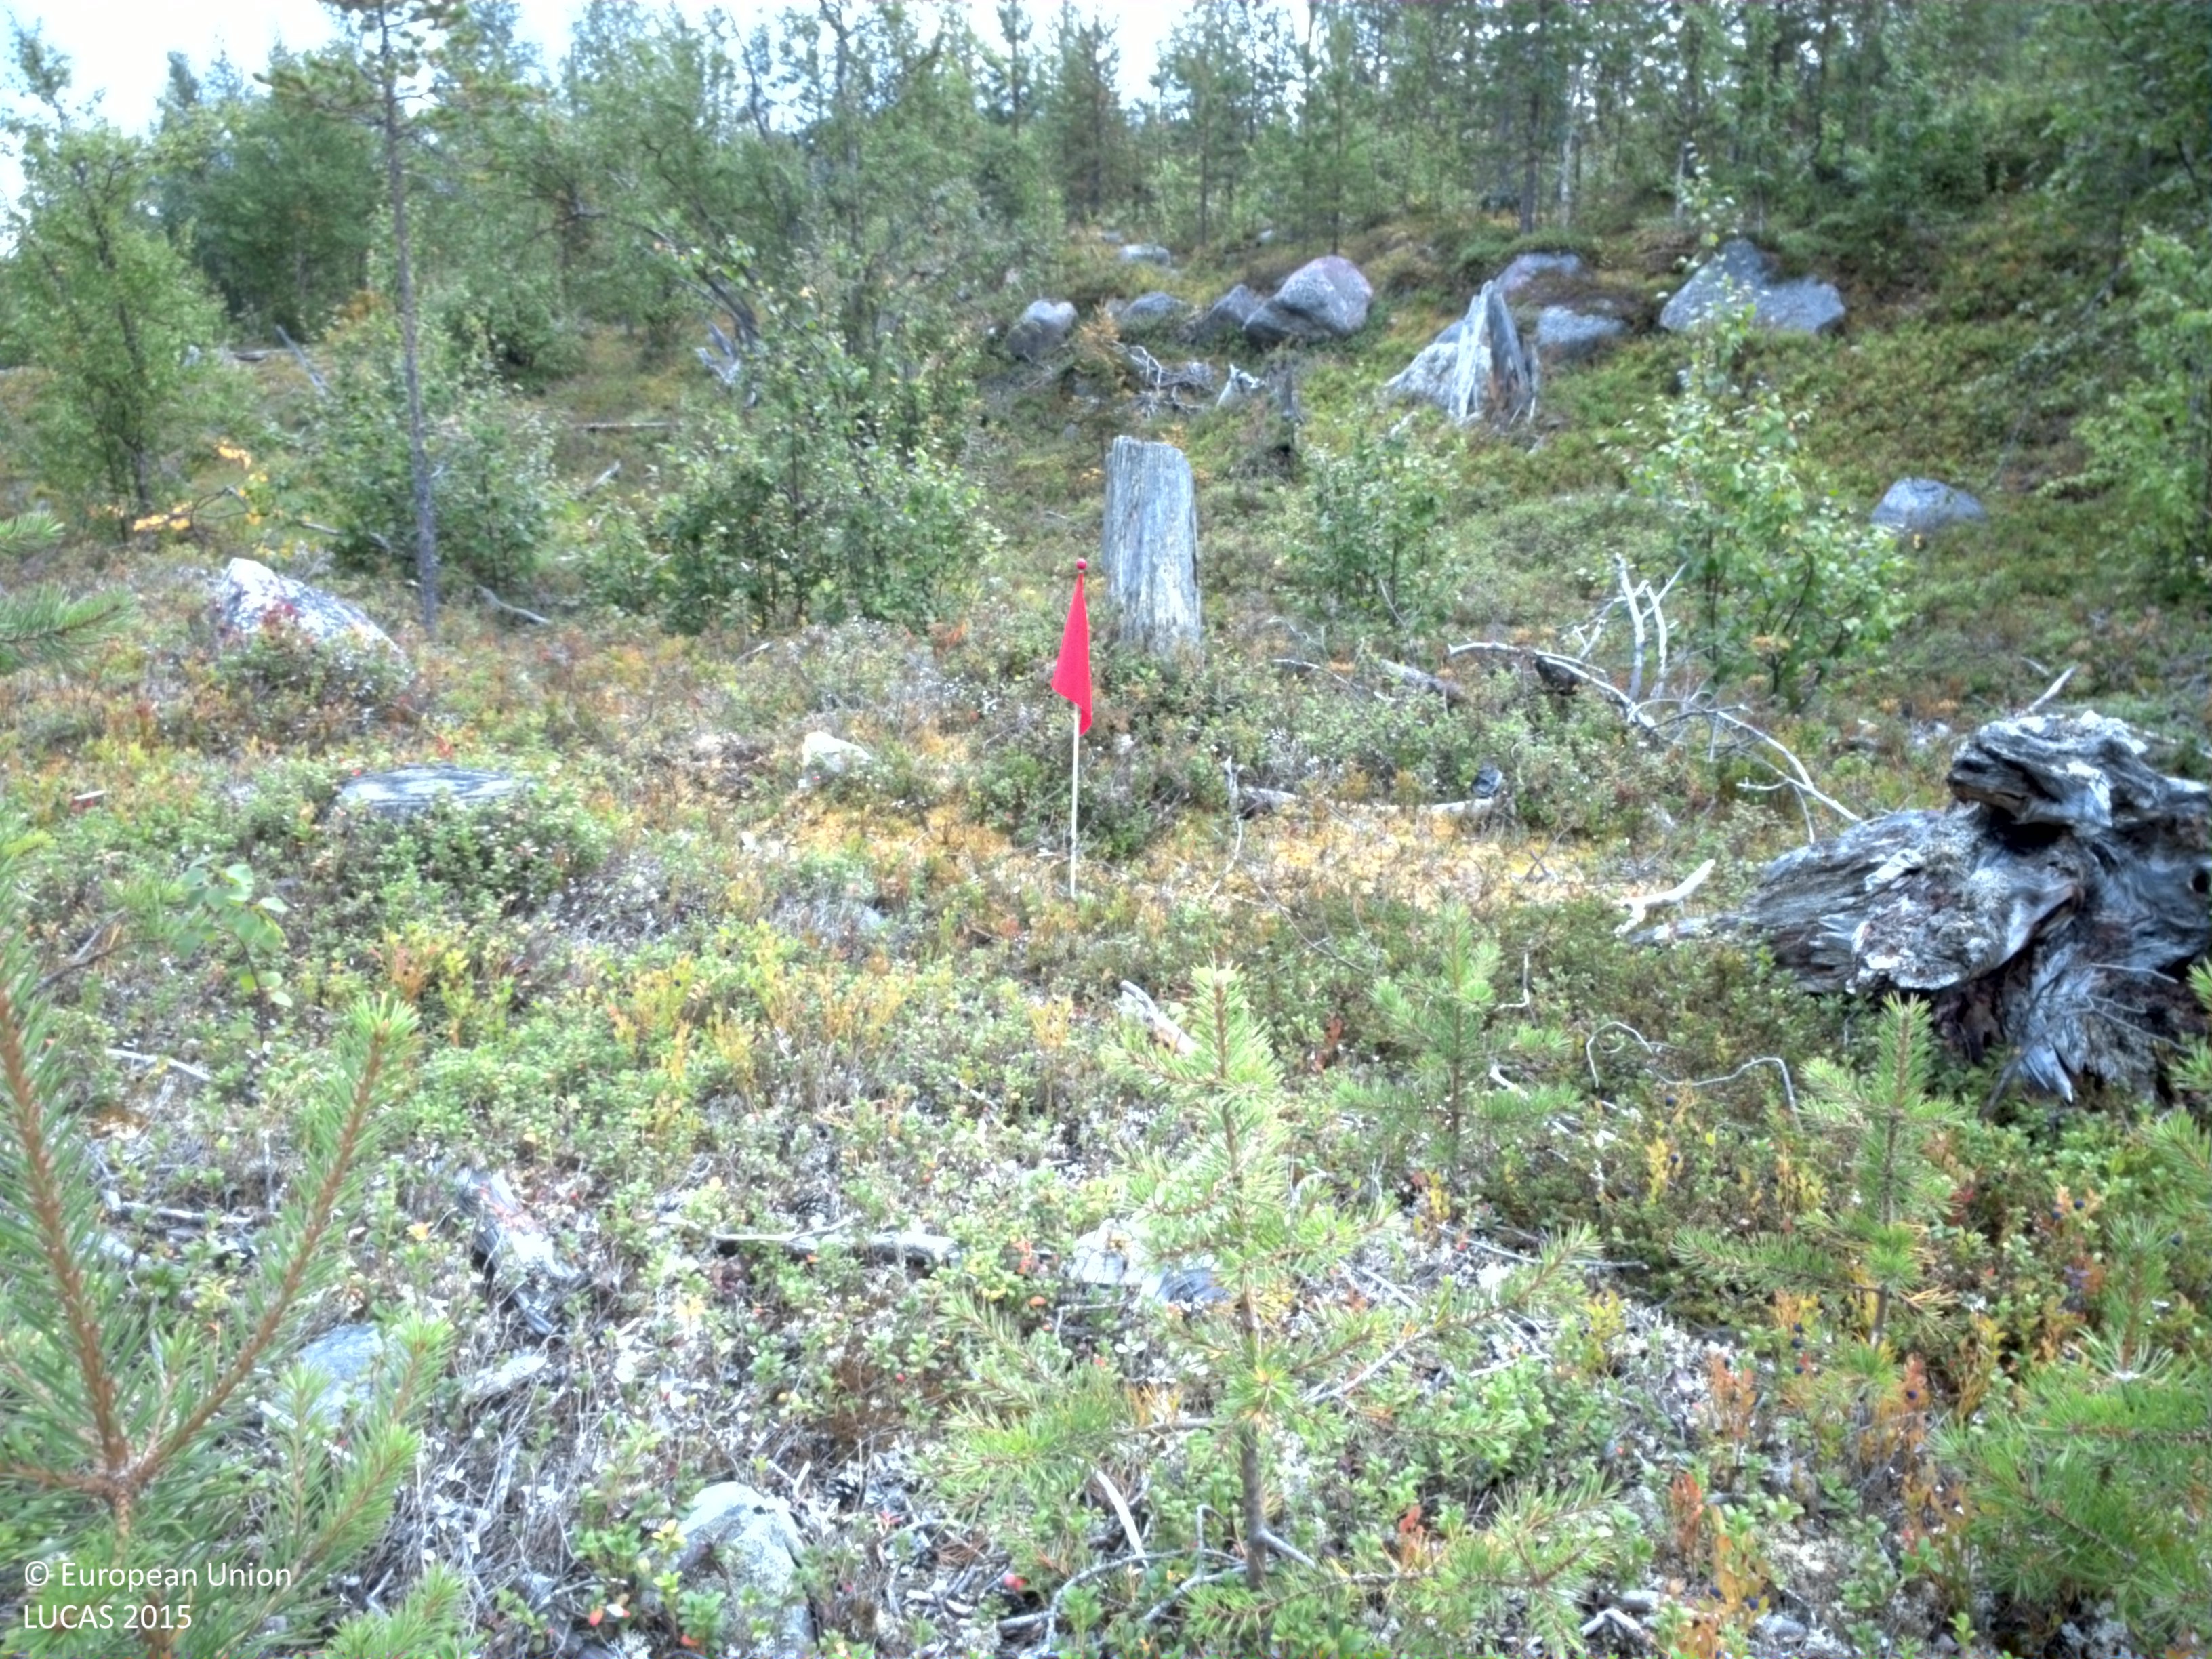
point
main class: Shrubland
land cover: Shrubland with sparse tree cover
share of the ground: > 75 %
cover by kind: shrubs 75 %, lichens and mosses 15 %, broadleaved forest trees 5 %, consolidated bare surface 5 %
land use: Forestry
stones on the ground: 25 - 50 %
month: August
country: SE
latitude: 66.5442
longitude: 19.3851
